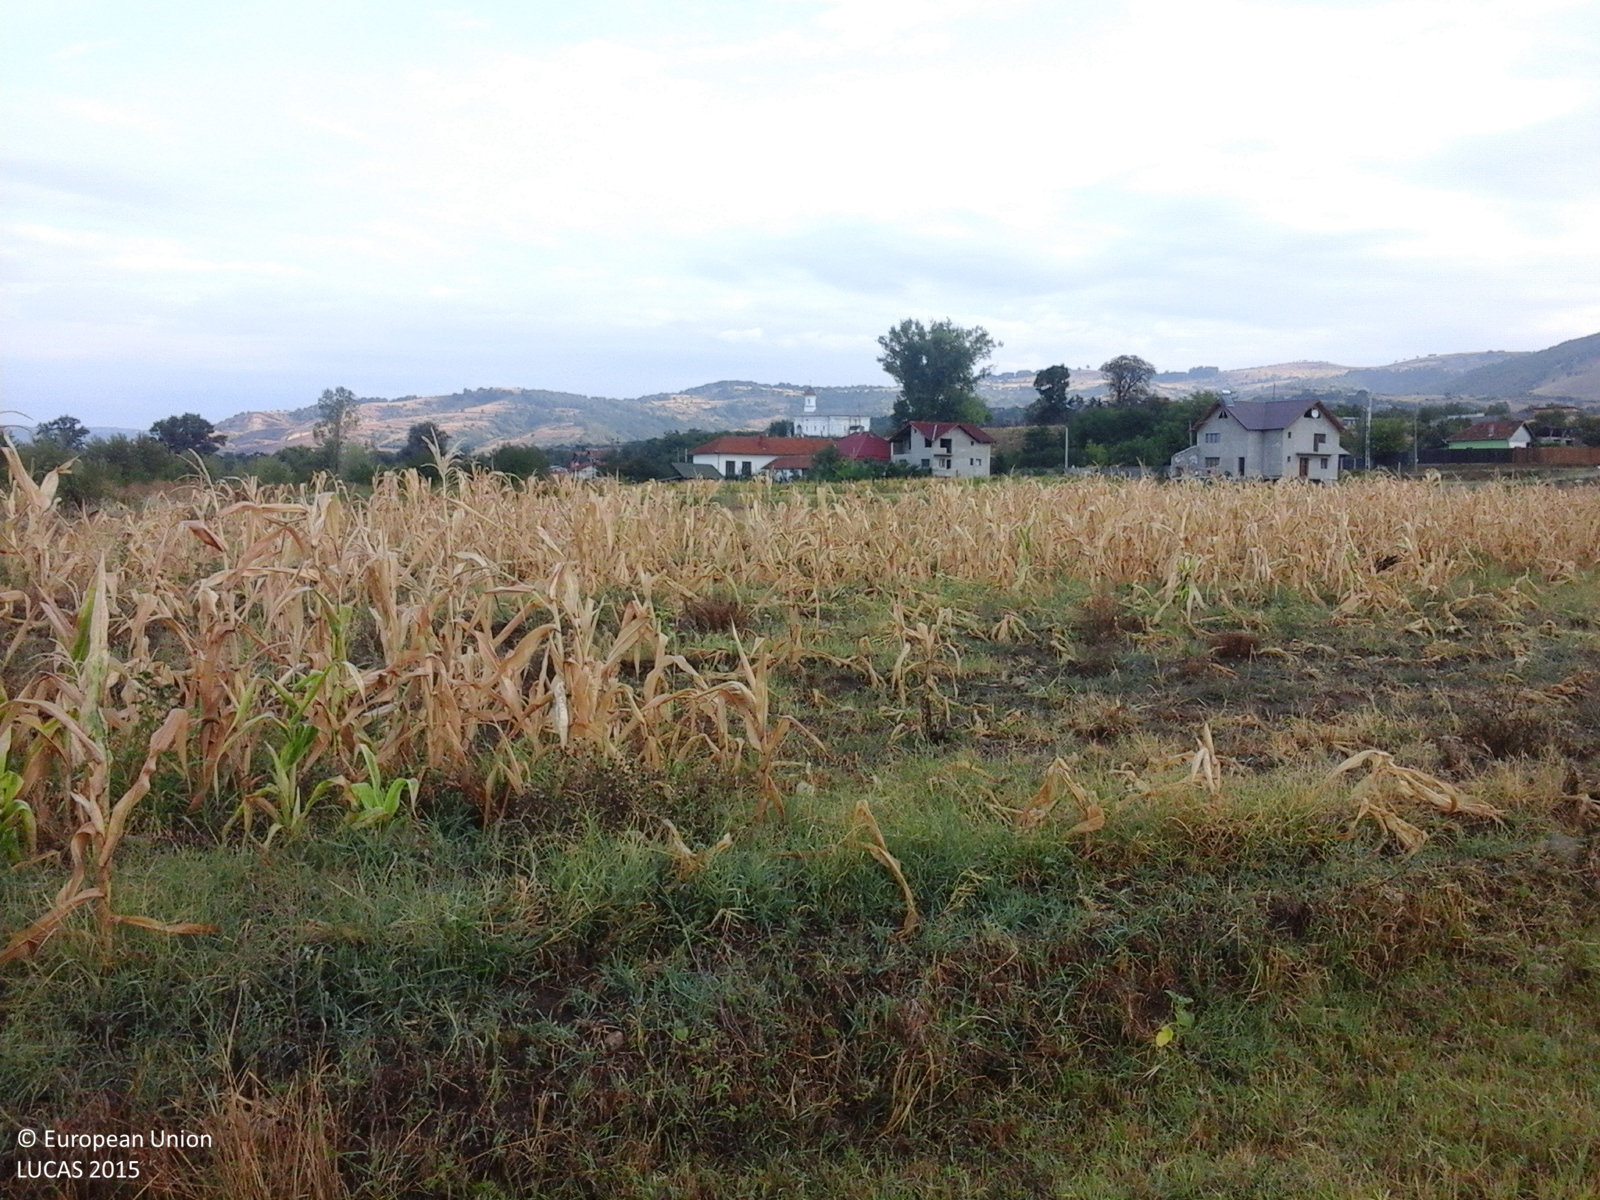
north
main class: Grassland
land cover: Grassland without tree/shrub cover
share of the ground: > 75 %
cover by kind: herbaceous plants 100 %
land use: Agriculture (excluding fallow land and kitchen gardens)
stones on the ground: < 10 %
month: August
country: RO
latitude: 44.7005
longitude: 22.6752
